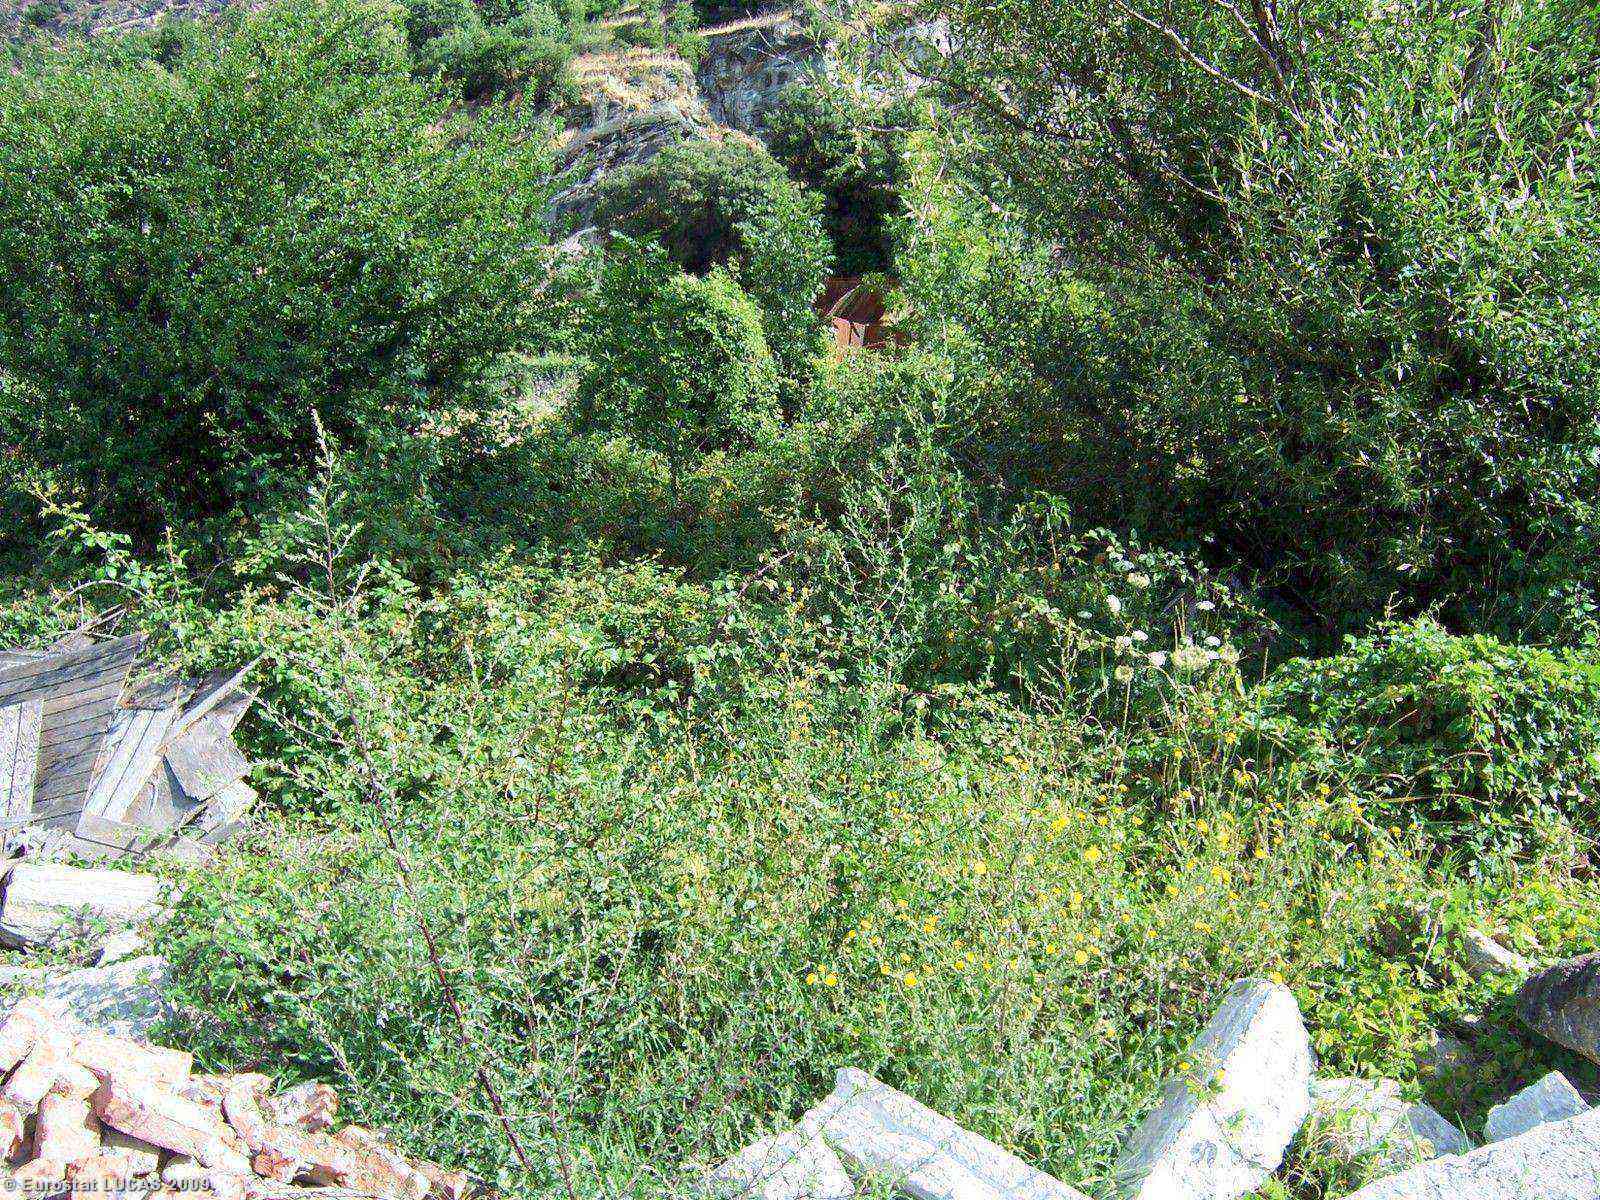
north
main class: Woodland
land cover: Broadleaved woodland
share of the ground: > 75 %
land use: Unused
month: July
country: IT
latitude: 45.1391
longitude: 7.0672
